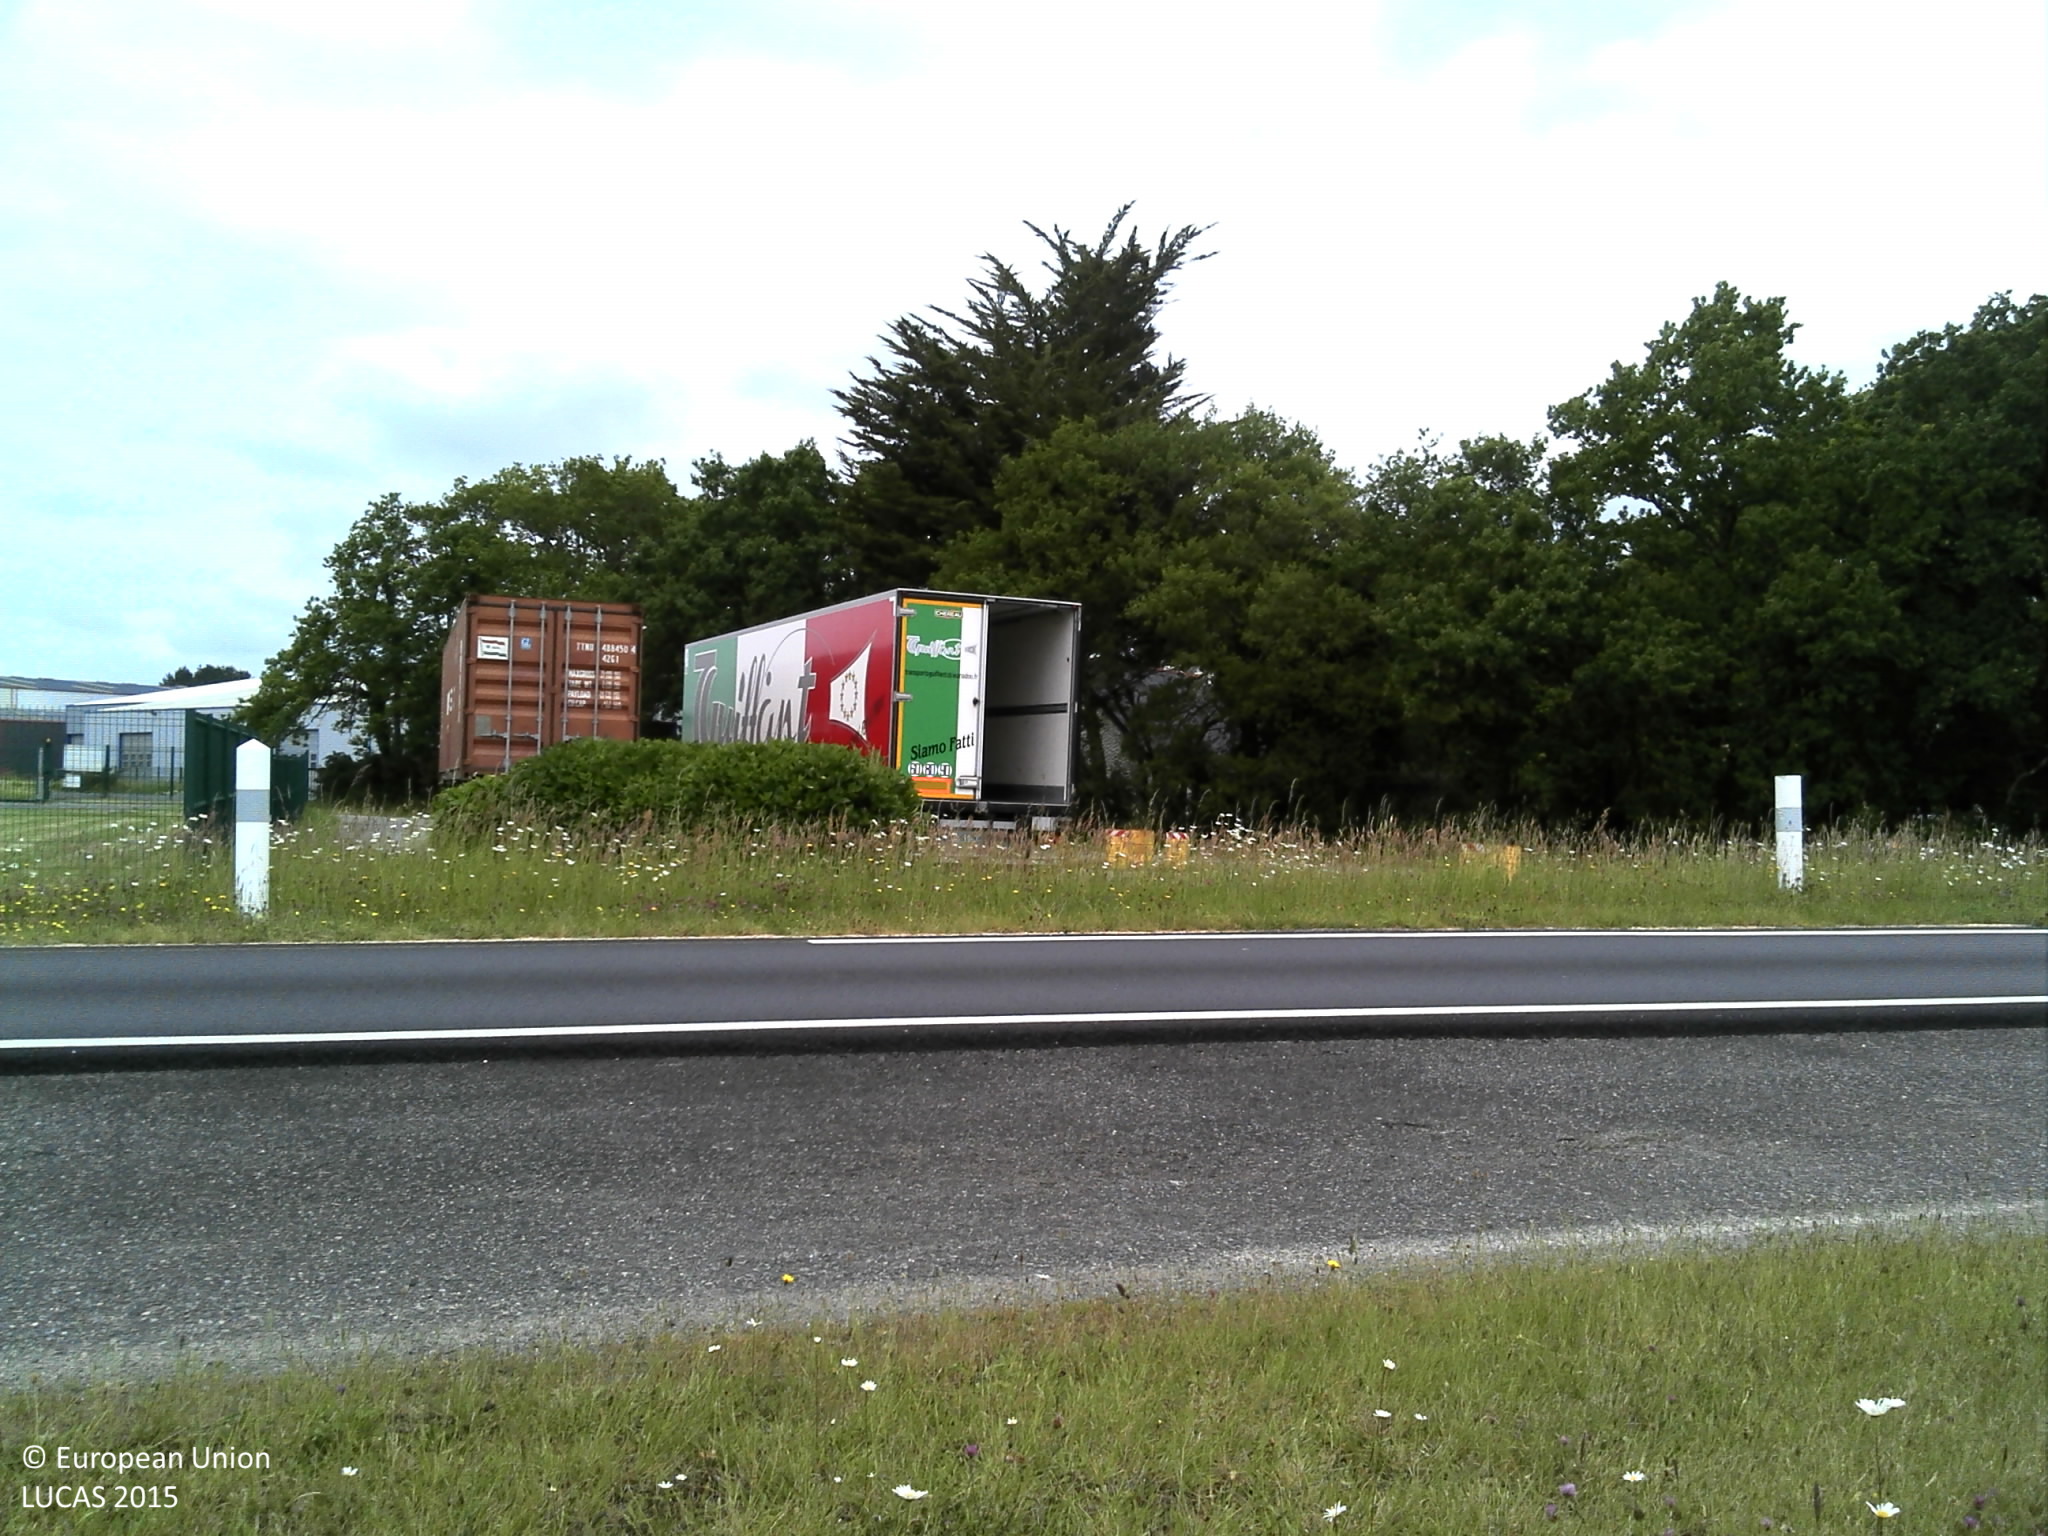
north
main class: Grassland
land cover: Grassland without tree/shrub cover
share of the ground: > 75 %
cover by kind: herbaceous plants 100 %
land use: Amenities, museums, leisure
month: May
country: FR
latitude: 47.8438
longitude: -3.5051
